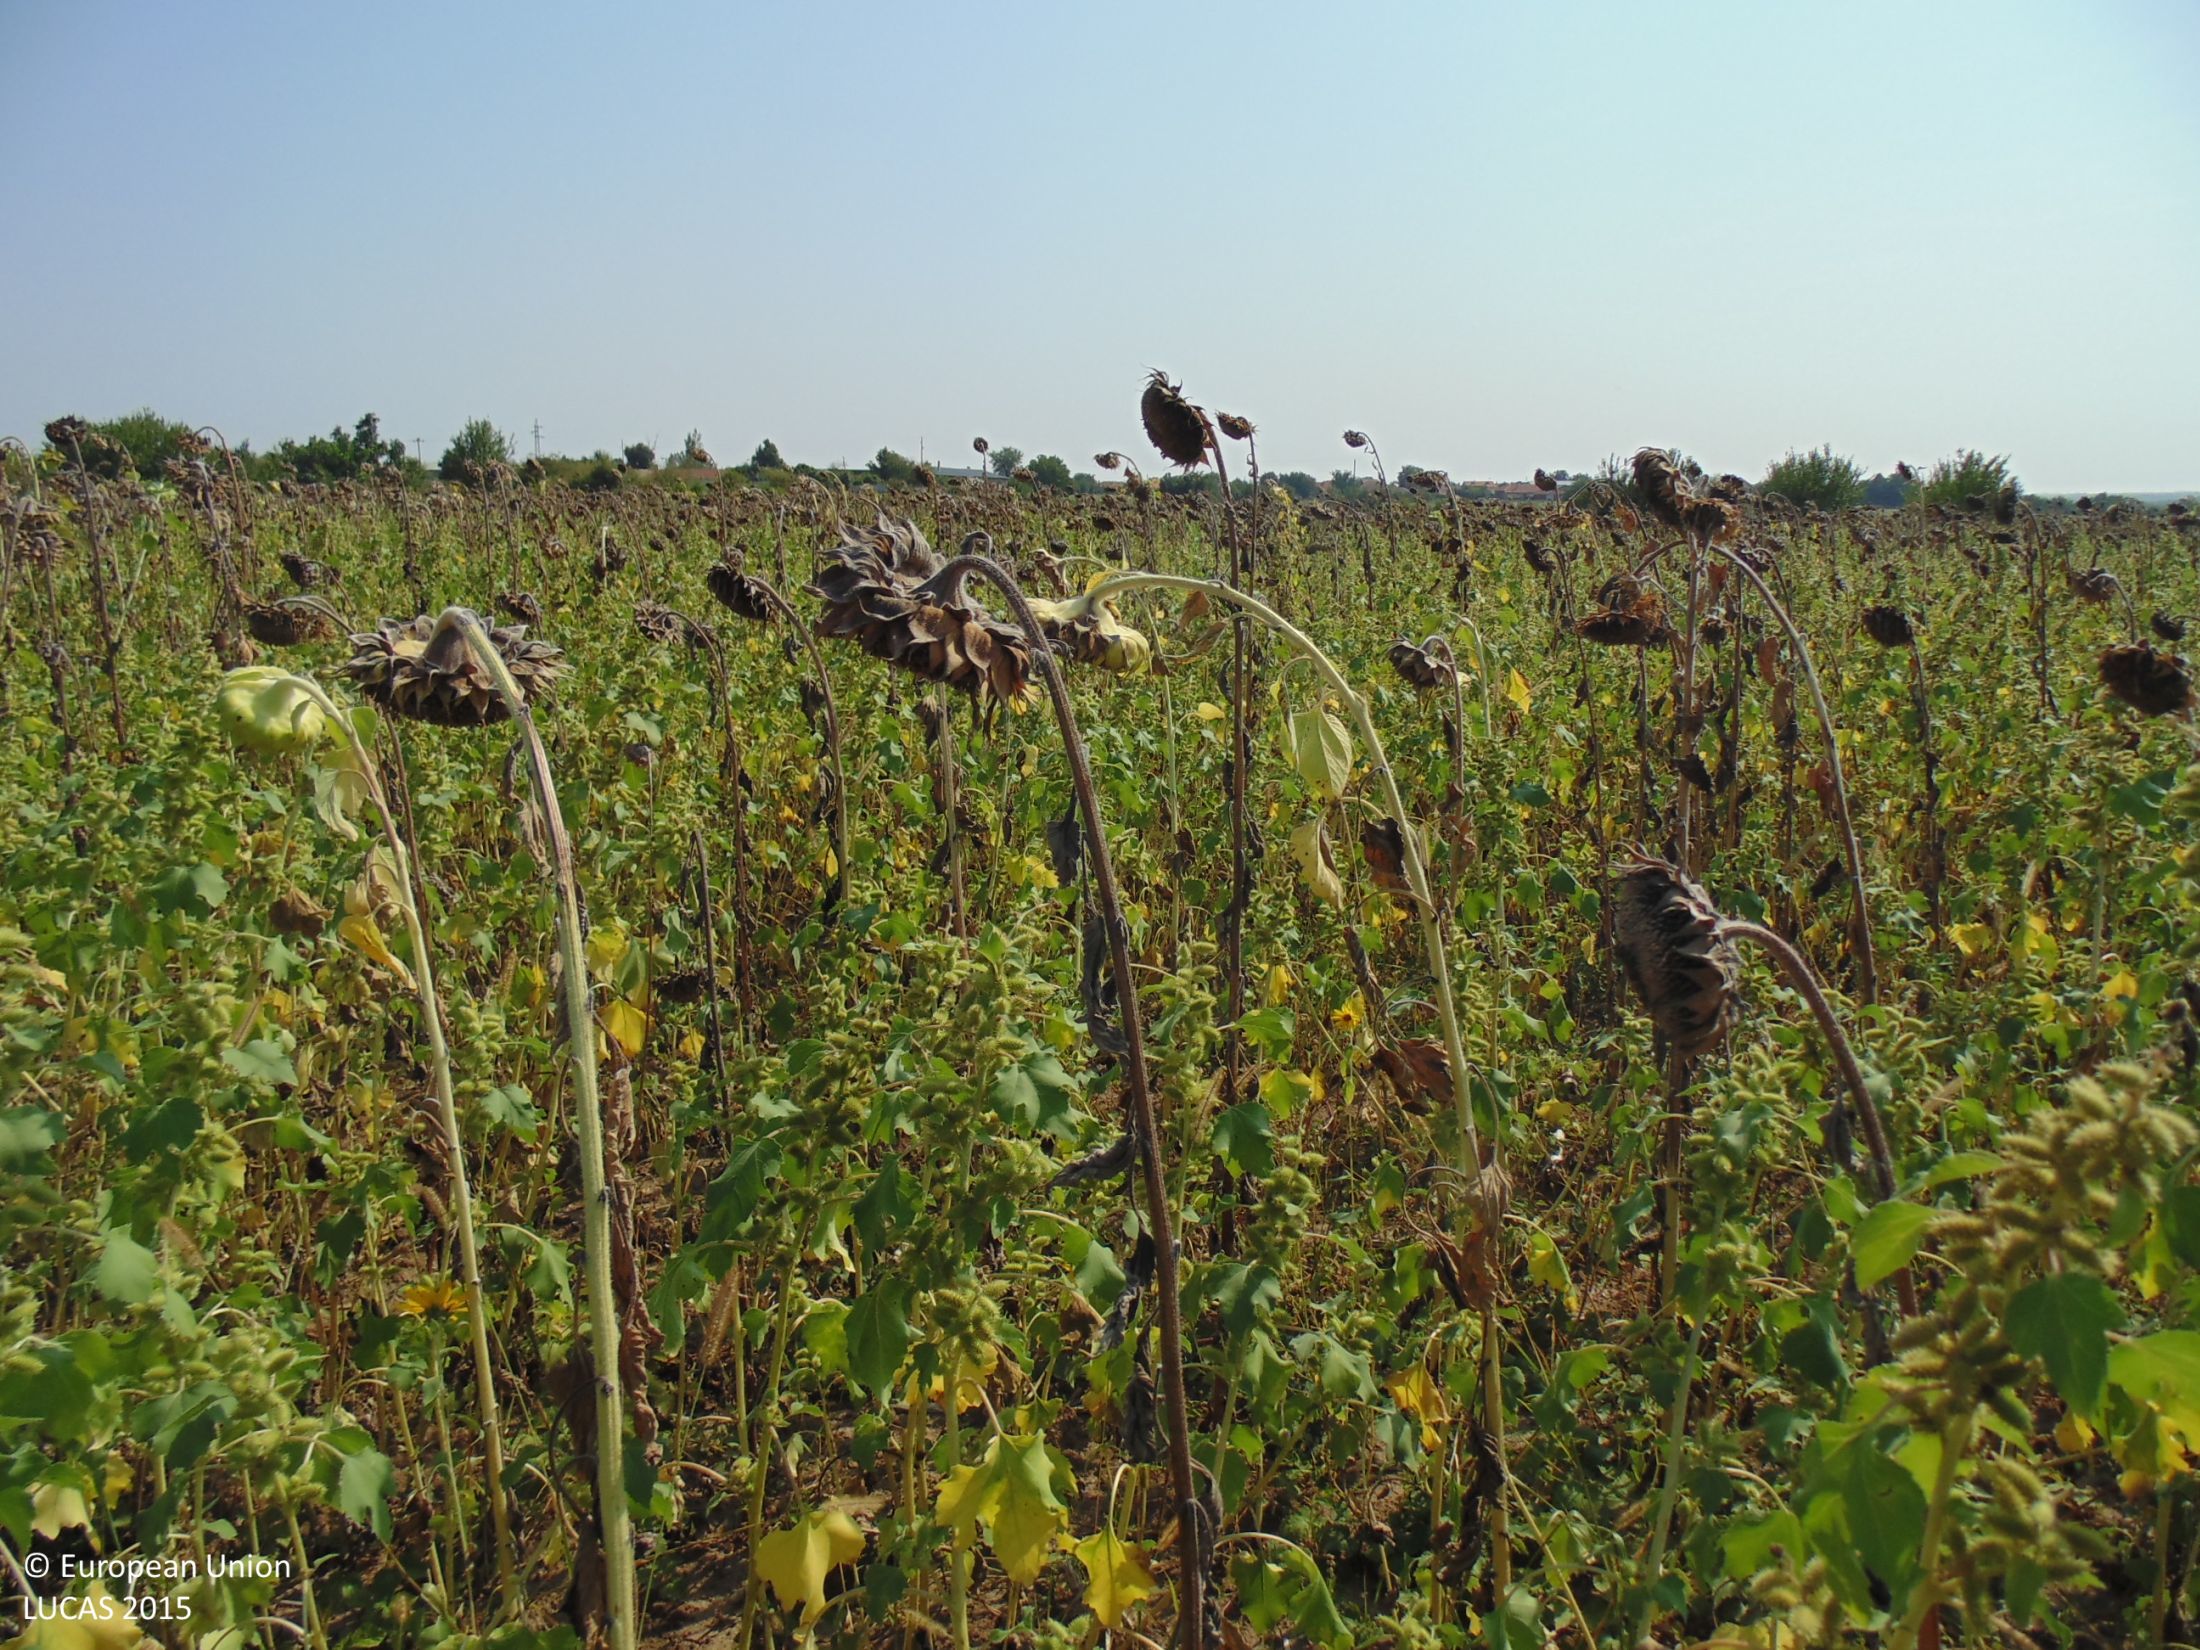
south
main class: Cropland
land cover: Sunflower
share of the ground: > 75 %
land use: Agriculture (excluding fallow land and kitchen gardens)
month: September
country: BG
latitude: 43.8319
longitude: 26.9200
